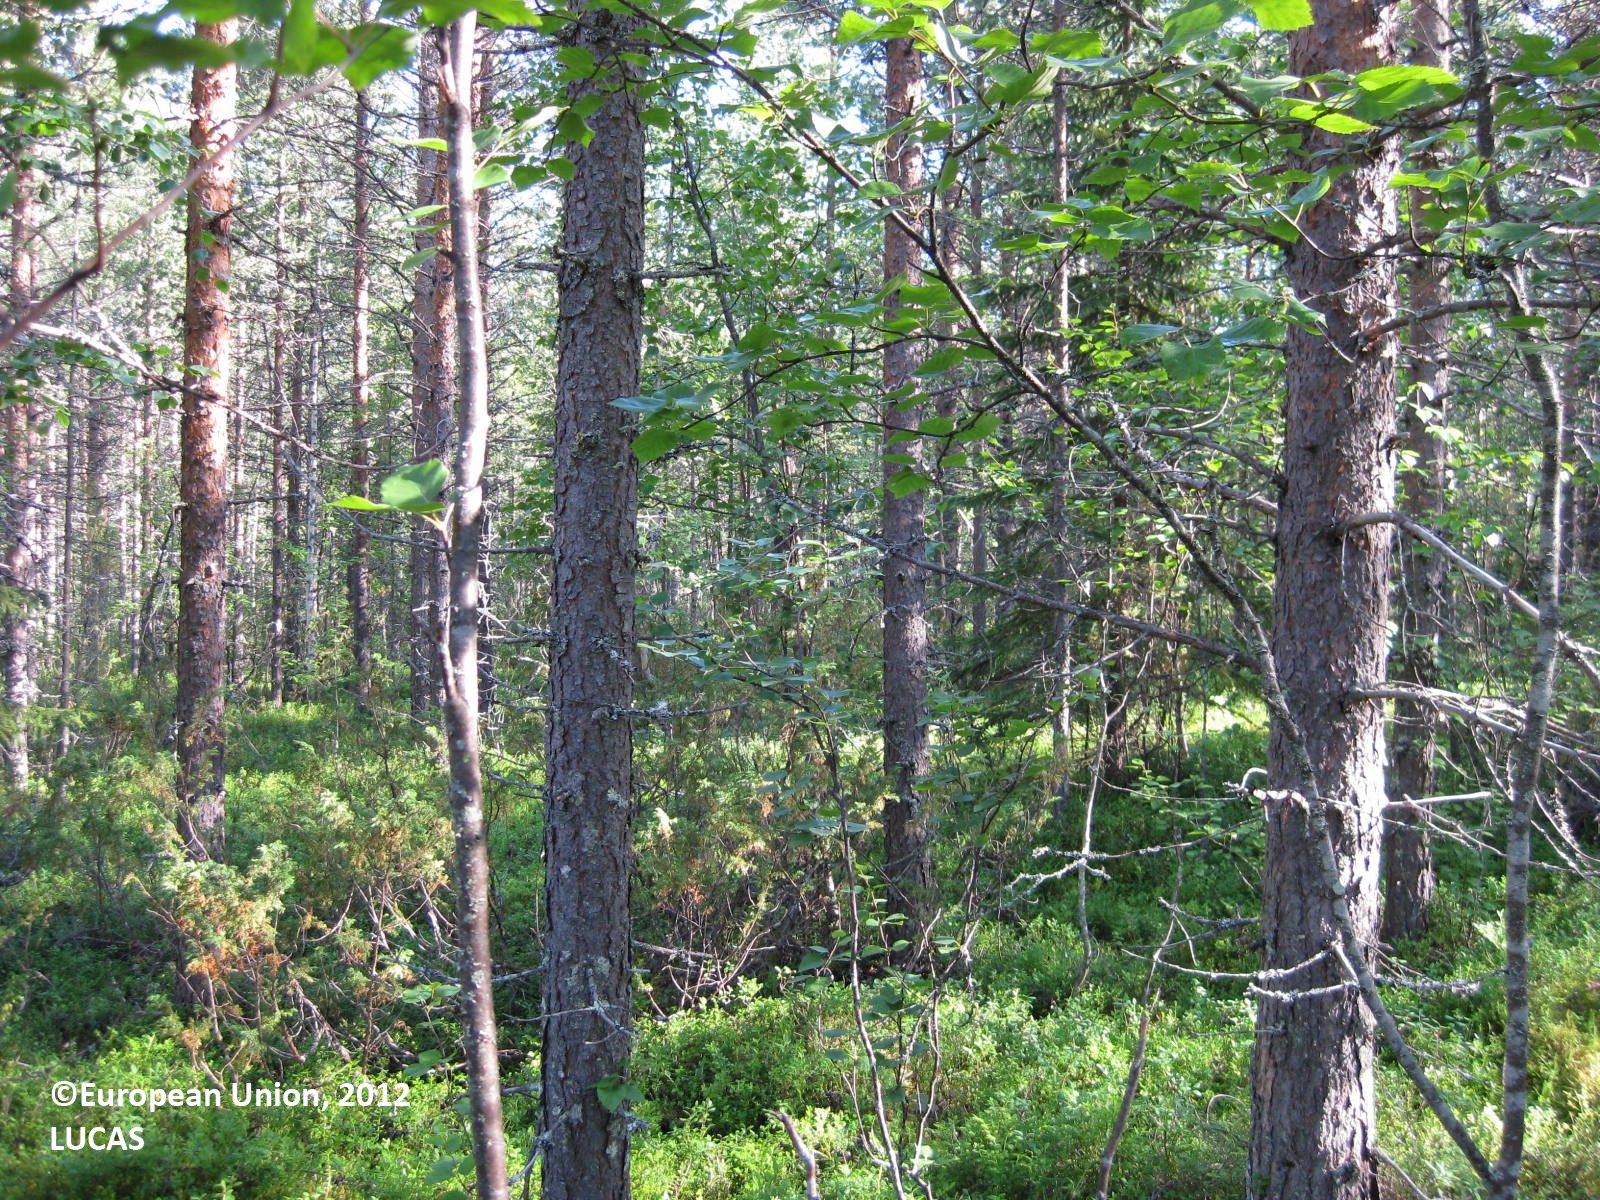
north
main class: Woodland
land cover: Pine dominated mixed woodland
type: boreal forest
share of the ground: > 75 %
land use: Forestry
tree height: > 5 m
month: July
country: FI
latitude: 65.6310
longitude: 28.3336
